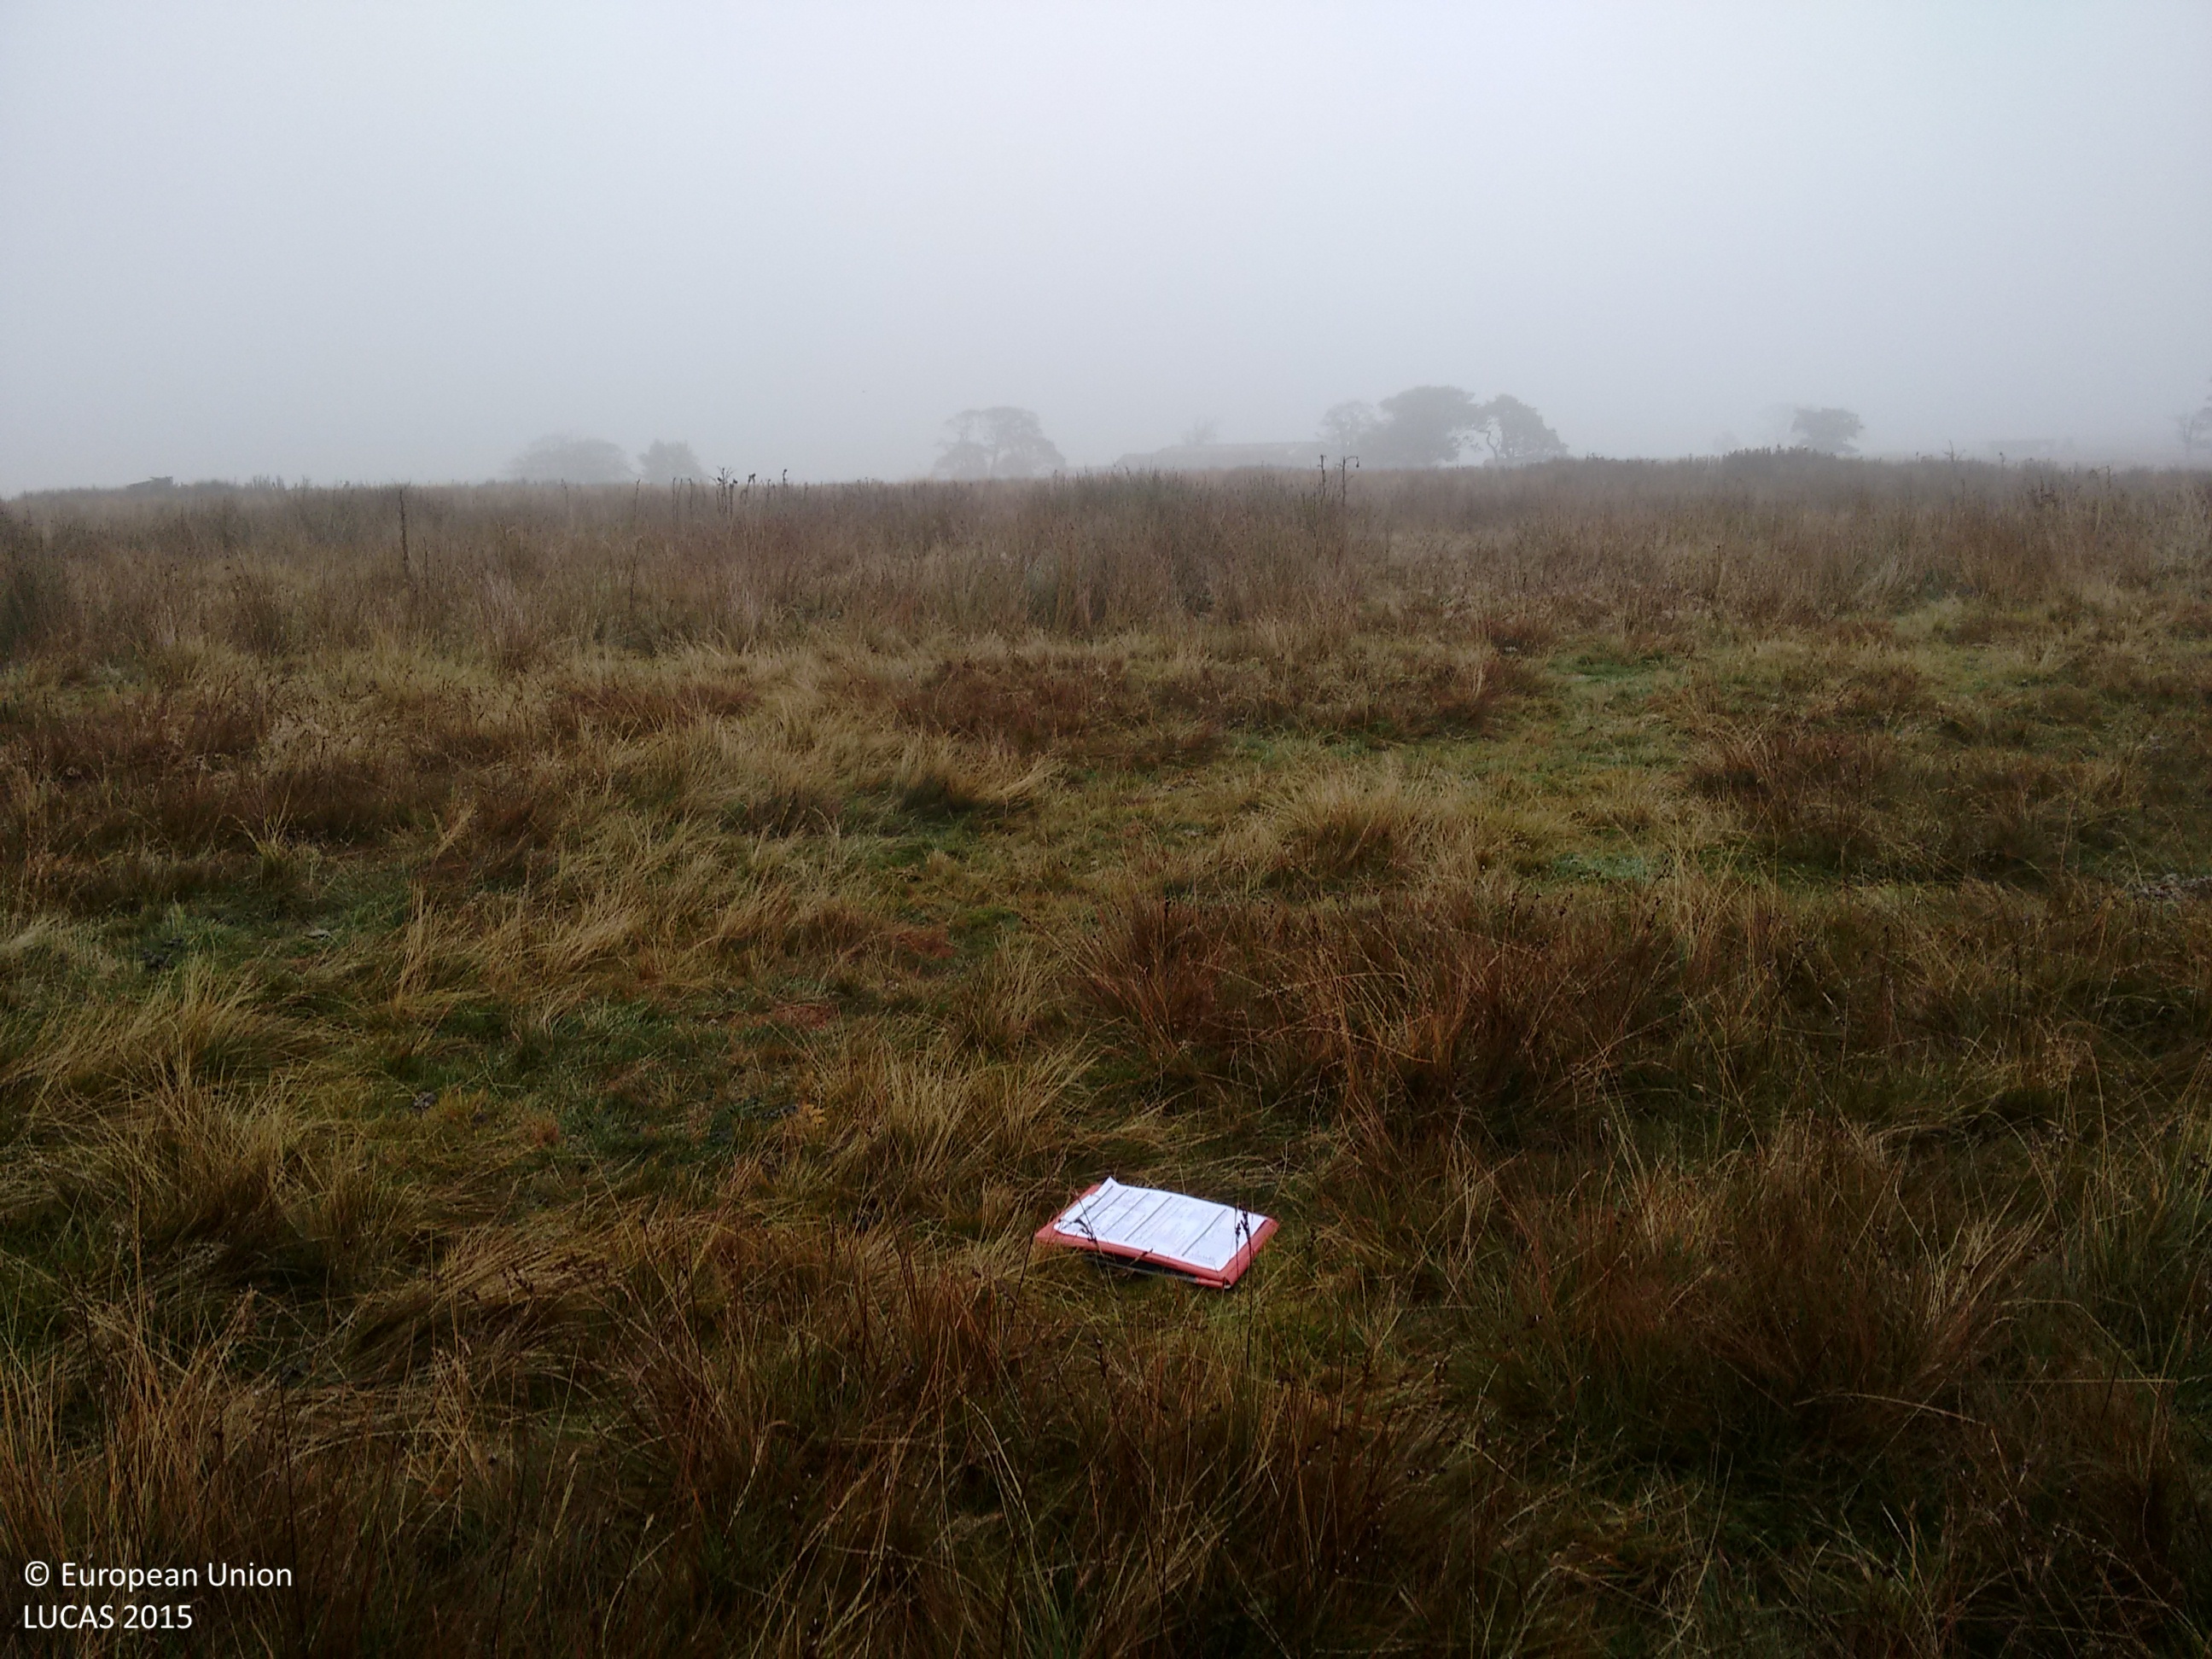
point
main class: Grassland
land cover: Grassland without tree/shrub cover
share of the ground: > 75 %
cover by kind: herbaceous plants 100 %
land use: Agriculture (excluding fallow land and kitchen gardens)
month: October
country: GB
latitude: 54.5274
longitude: -2.0313
